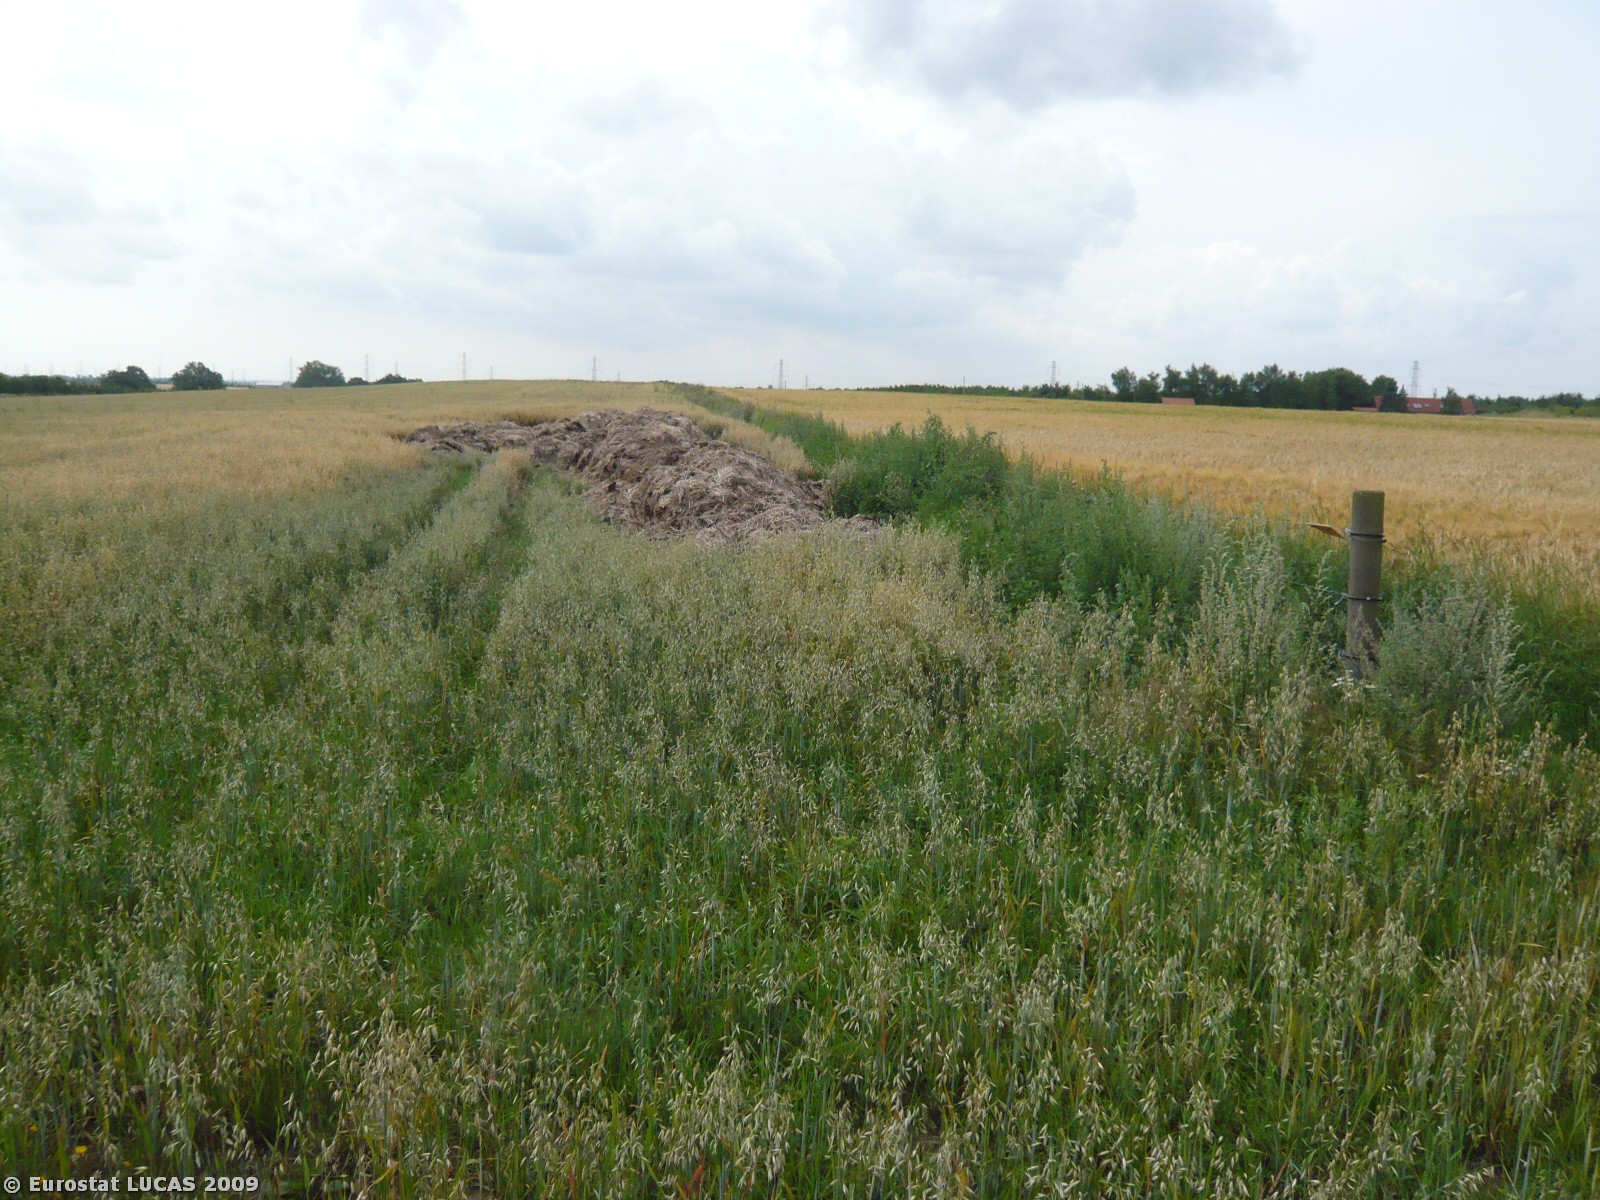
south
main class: Grassland
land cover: Grassland without tree/shrub cover
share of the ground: > 75 %
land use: Agriculture (excluding fallow land and kitchen gardens)
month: July
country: DK
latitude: 55.8095
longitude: 12.1841
